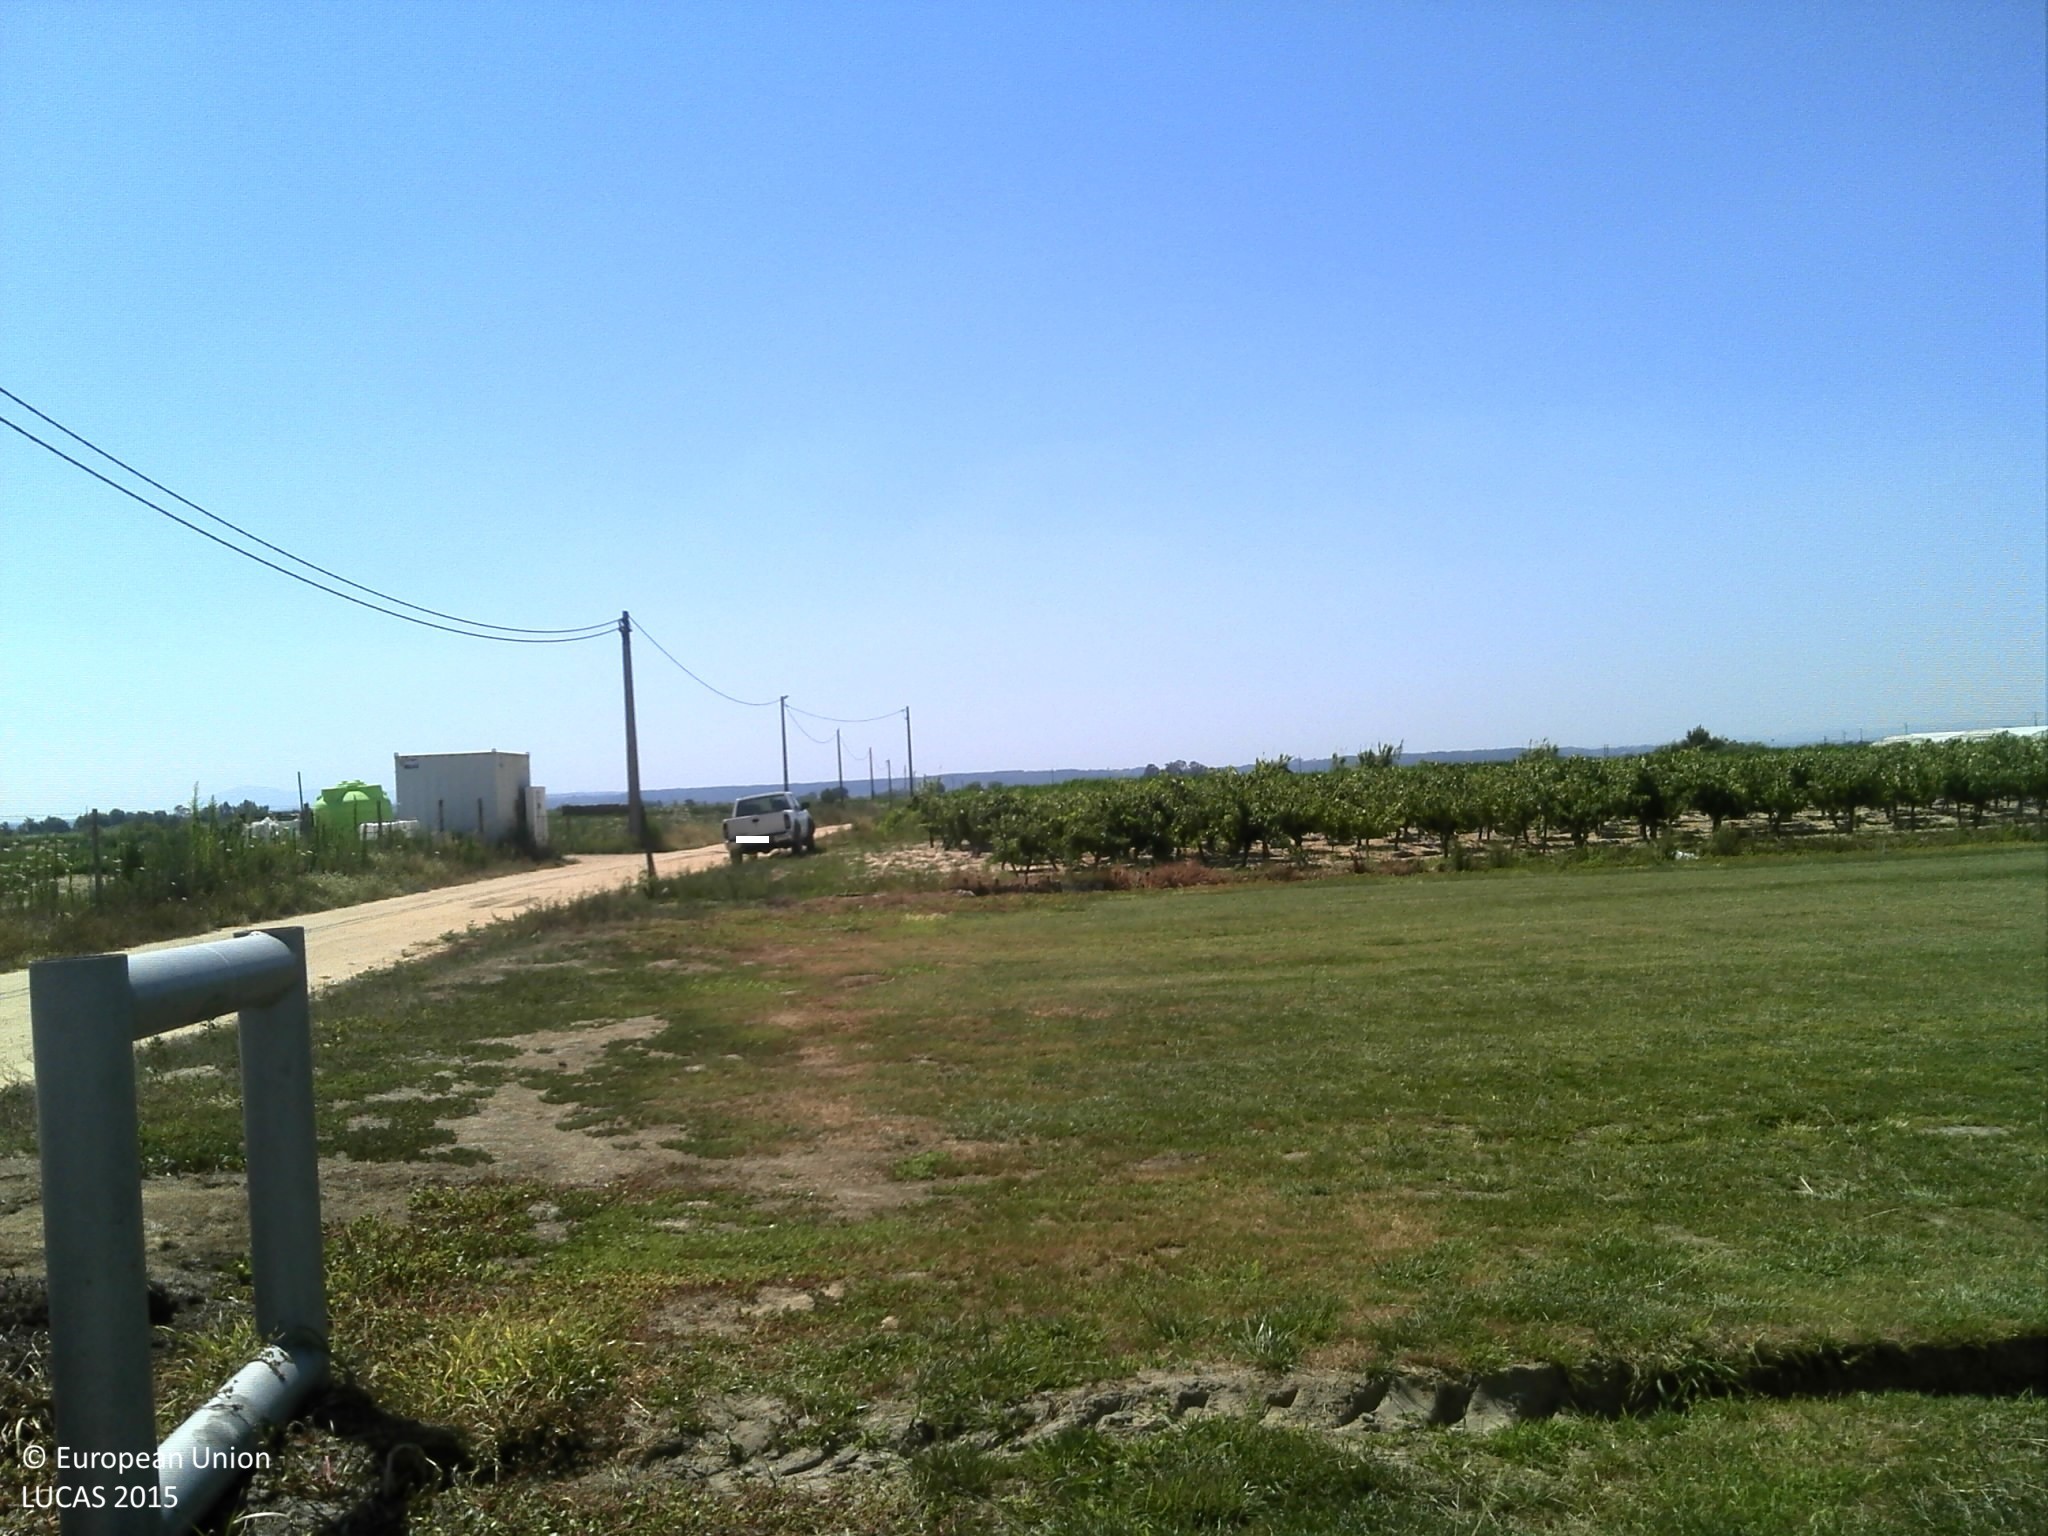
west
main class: Cropland
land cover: Nurseries
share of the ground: > 75 %
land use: Agriculture (excluding fallow land and kitchen gardens)
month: June
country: PT
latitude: 39.1478
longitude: -8.6408
